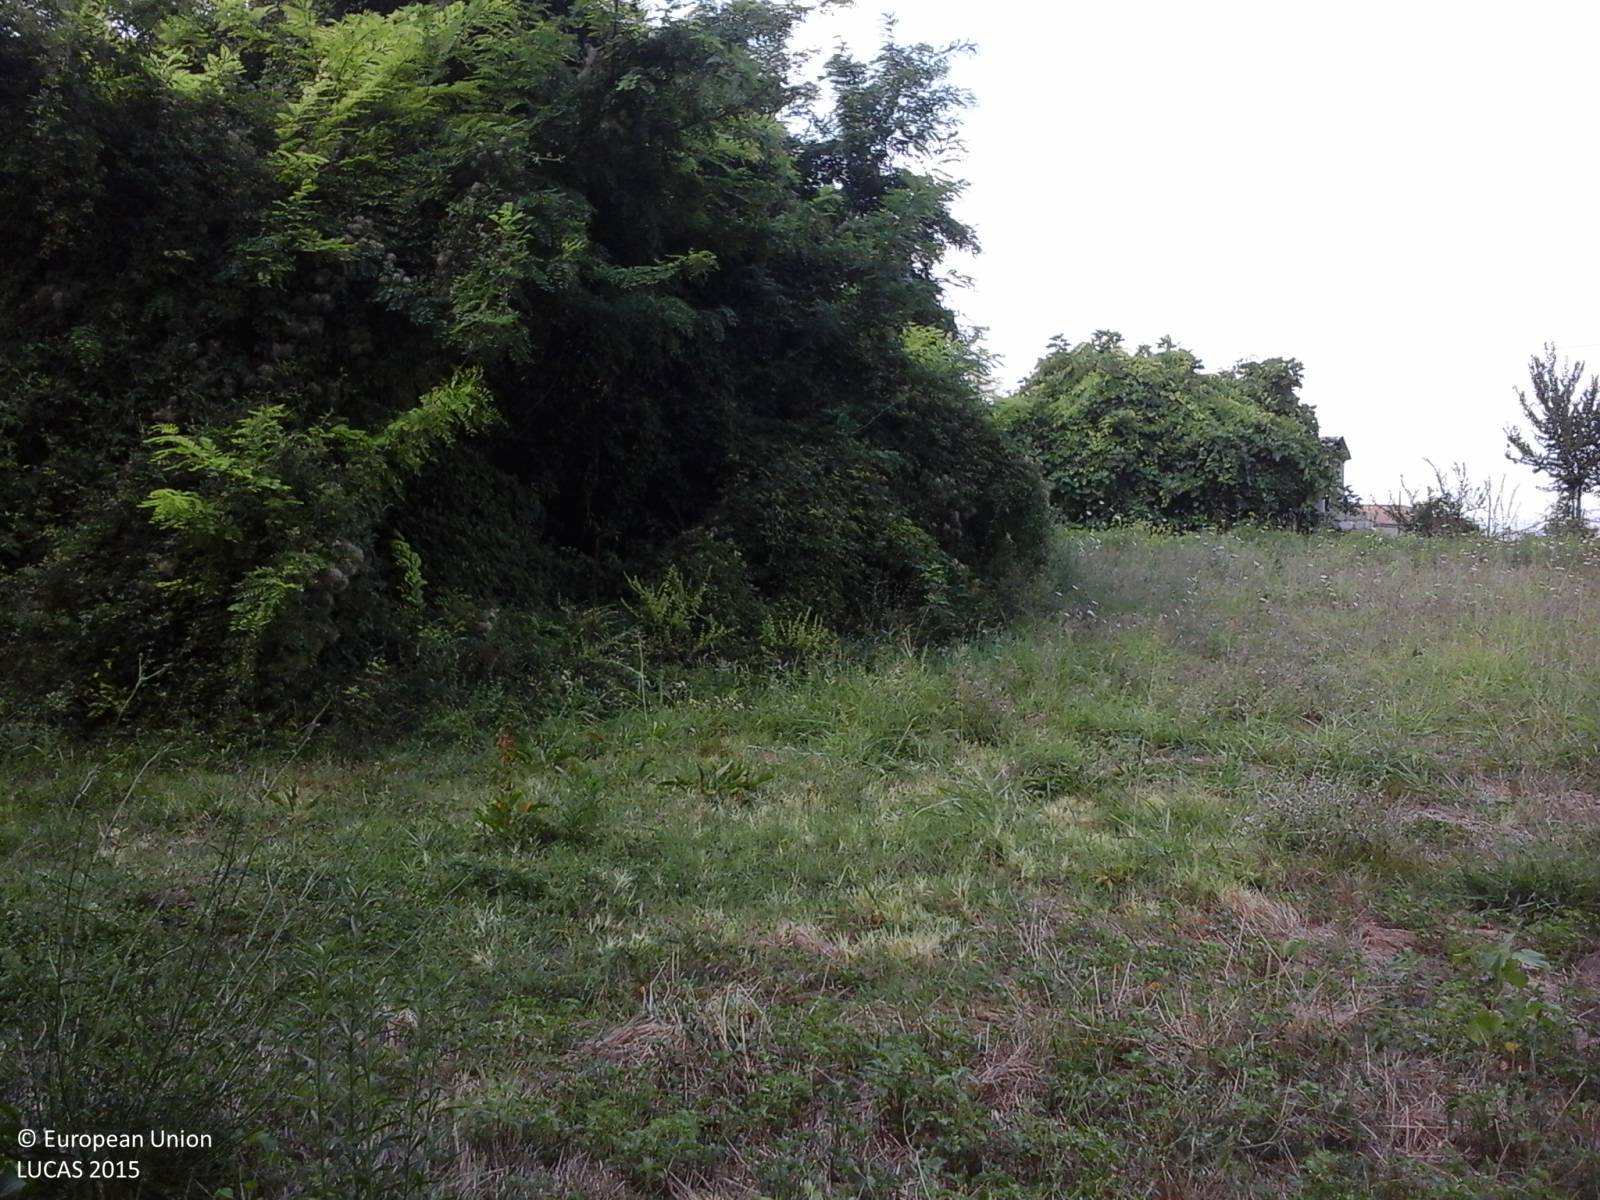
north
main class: Woodland
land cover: Broadleaved woodland
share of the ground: > 75 %
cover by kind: broadleaved forest trees 100 %
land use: Semi-natural and natural areas not in use
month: August
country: IT
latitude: 41.4421
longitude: 13.8274
